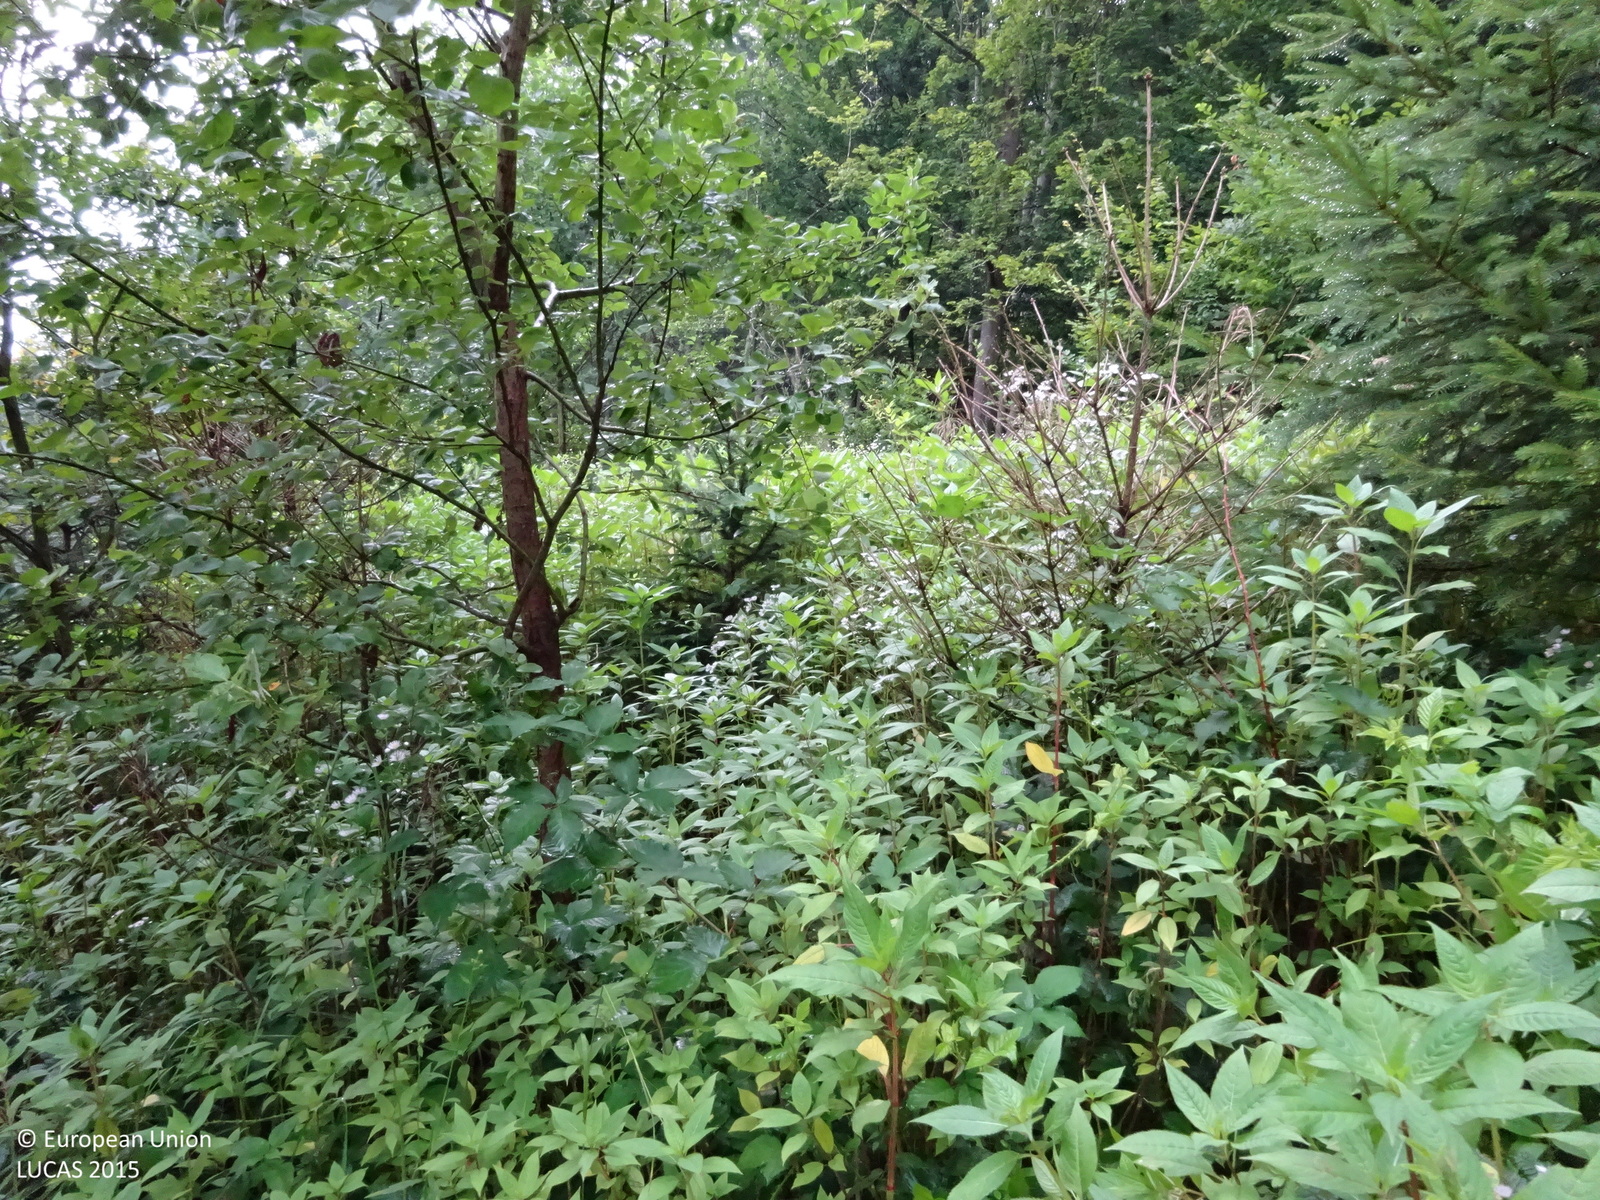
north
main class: Woodland
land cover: Spruce dominated coniferous woodland
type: alpine coniferous forest
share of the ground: 50 - 75 %
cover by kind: coniferous forest trees 60 %, herbaceous plants 20 %, broadleaved forest trees 10 %, shrubs 10 %
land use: Forestry
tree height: > 5 m
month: July
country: AT
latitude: 46.7984
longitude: 15.2791
